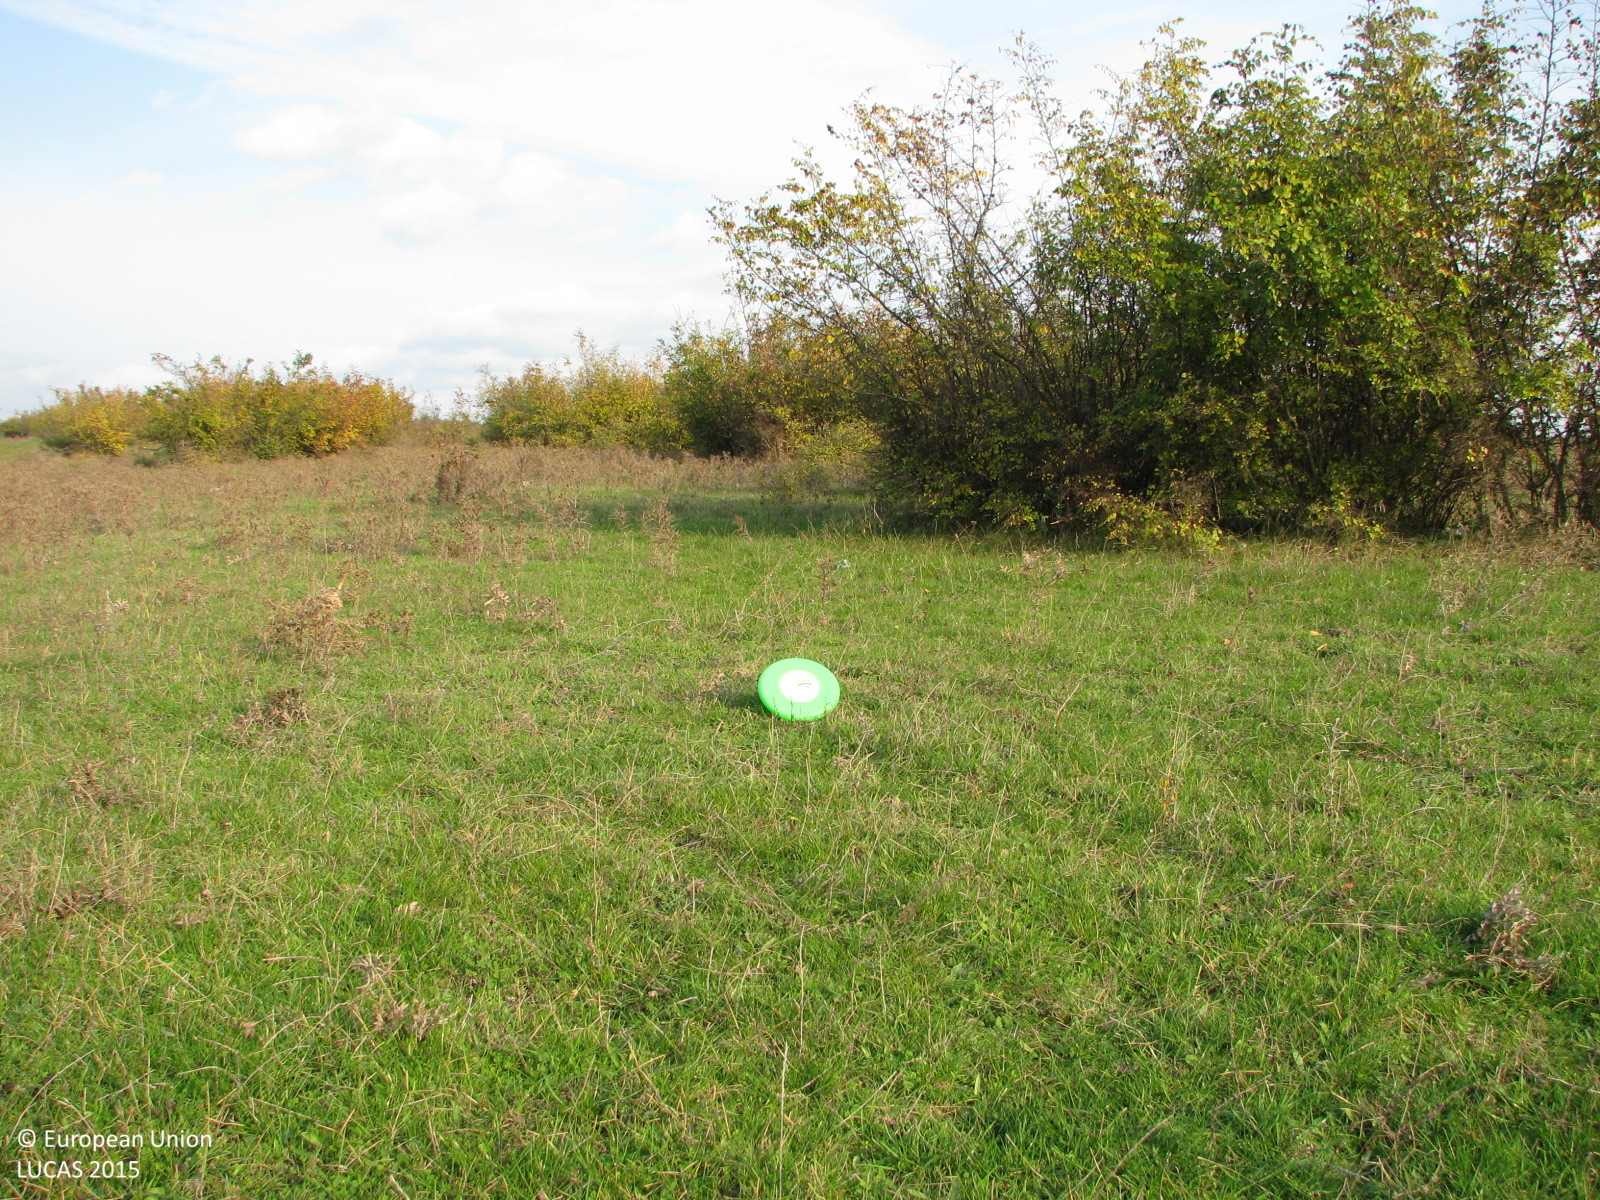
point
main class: Grassland
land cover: Grassland with sparse tree/shrub cover
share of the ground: > 75 %
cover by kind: herbaceous plants 90 %, broadleaved forest trees 5 %, shrubs 5 %
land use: Agriculture (excluding fallow land and kitchen gardens)
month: October
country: BG
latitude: 42.2599
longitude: 26.6394
